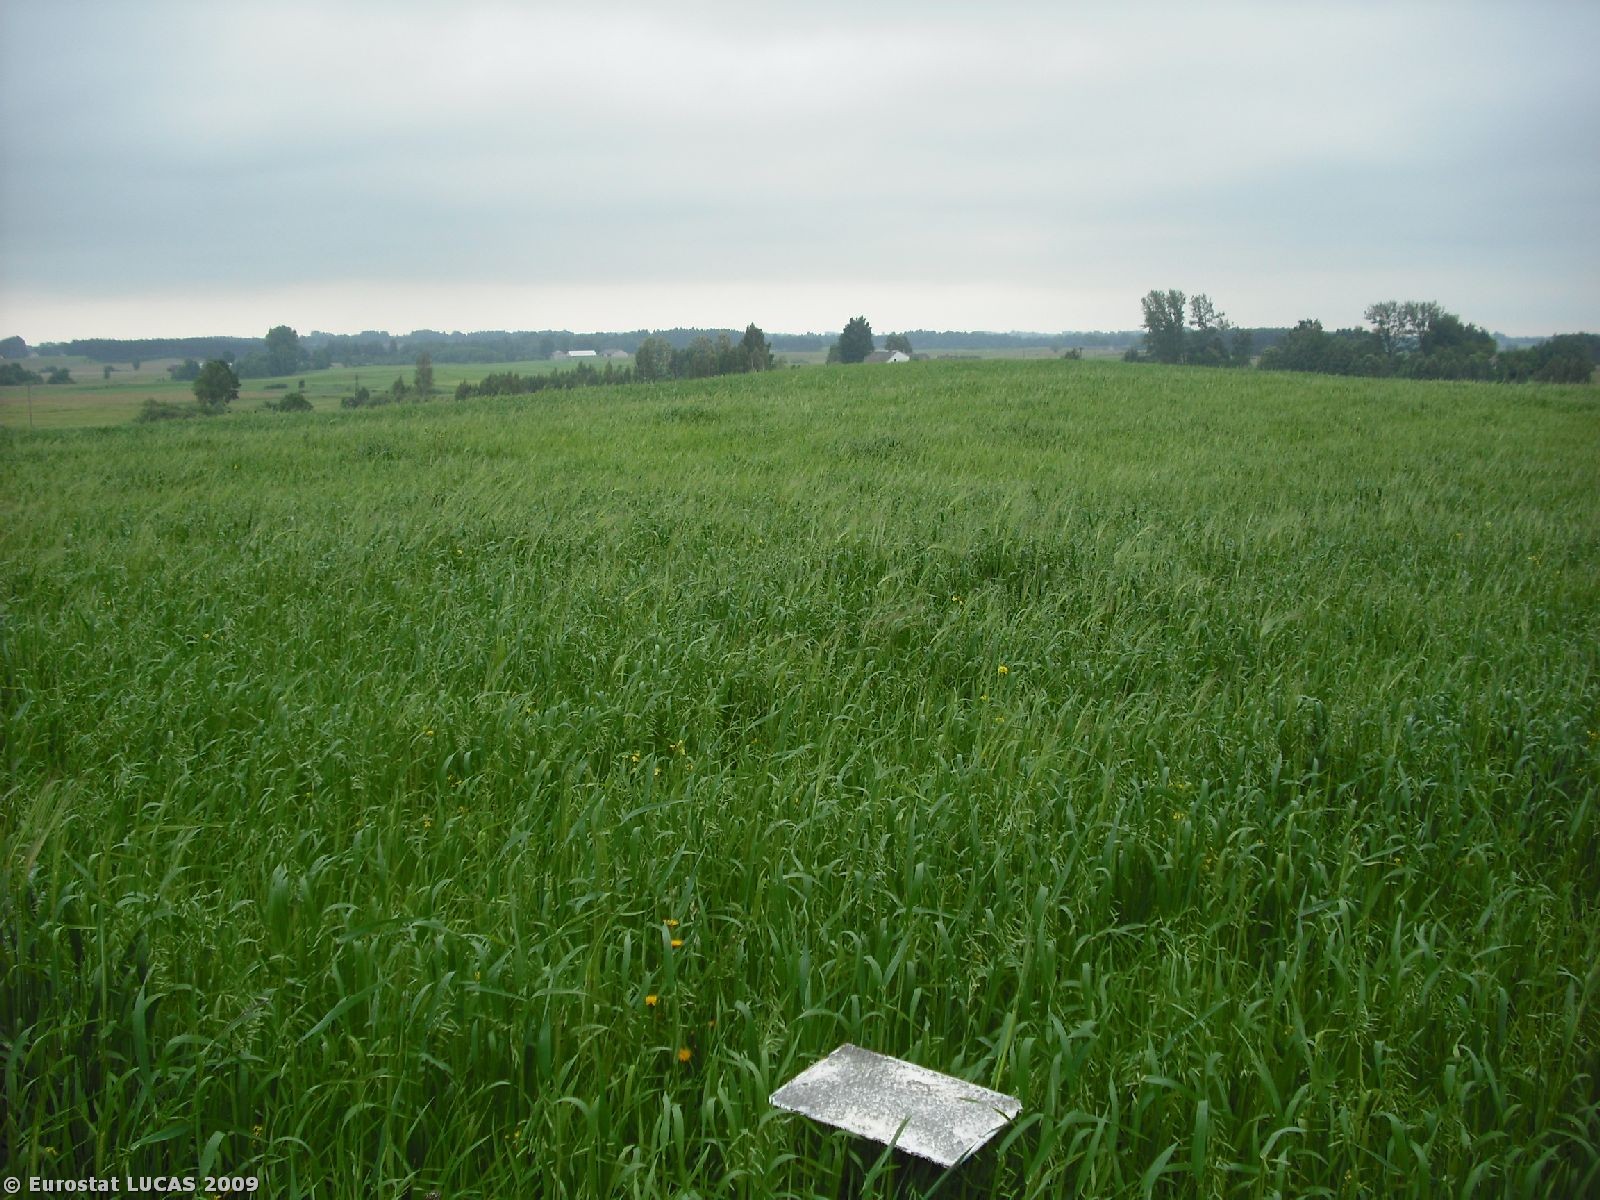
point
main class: Cropland
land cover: Oats
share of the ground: > 75 %
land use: Agriculture (excluding fallow land and kitchen gardens)
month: June
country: PL
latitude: 54.1026
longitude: 22.8092
